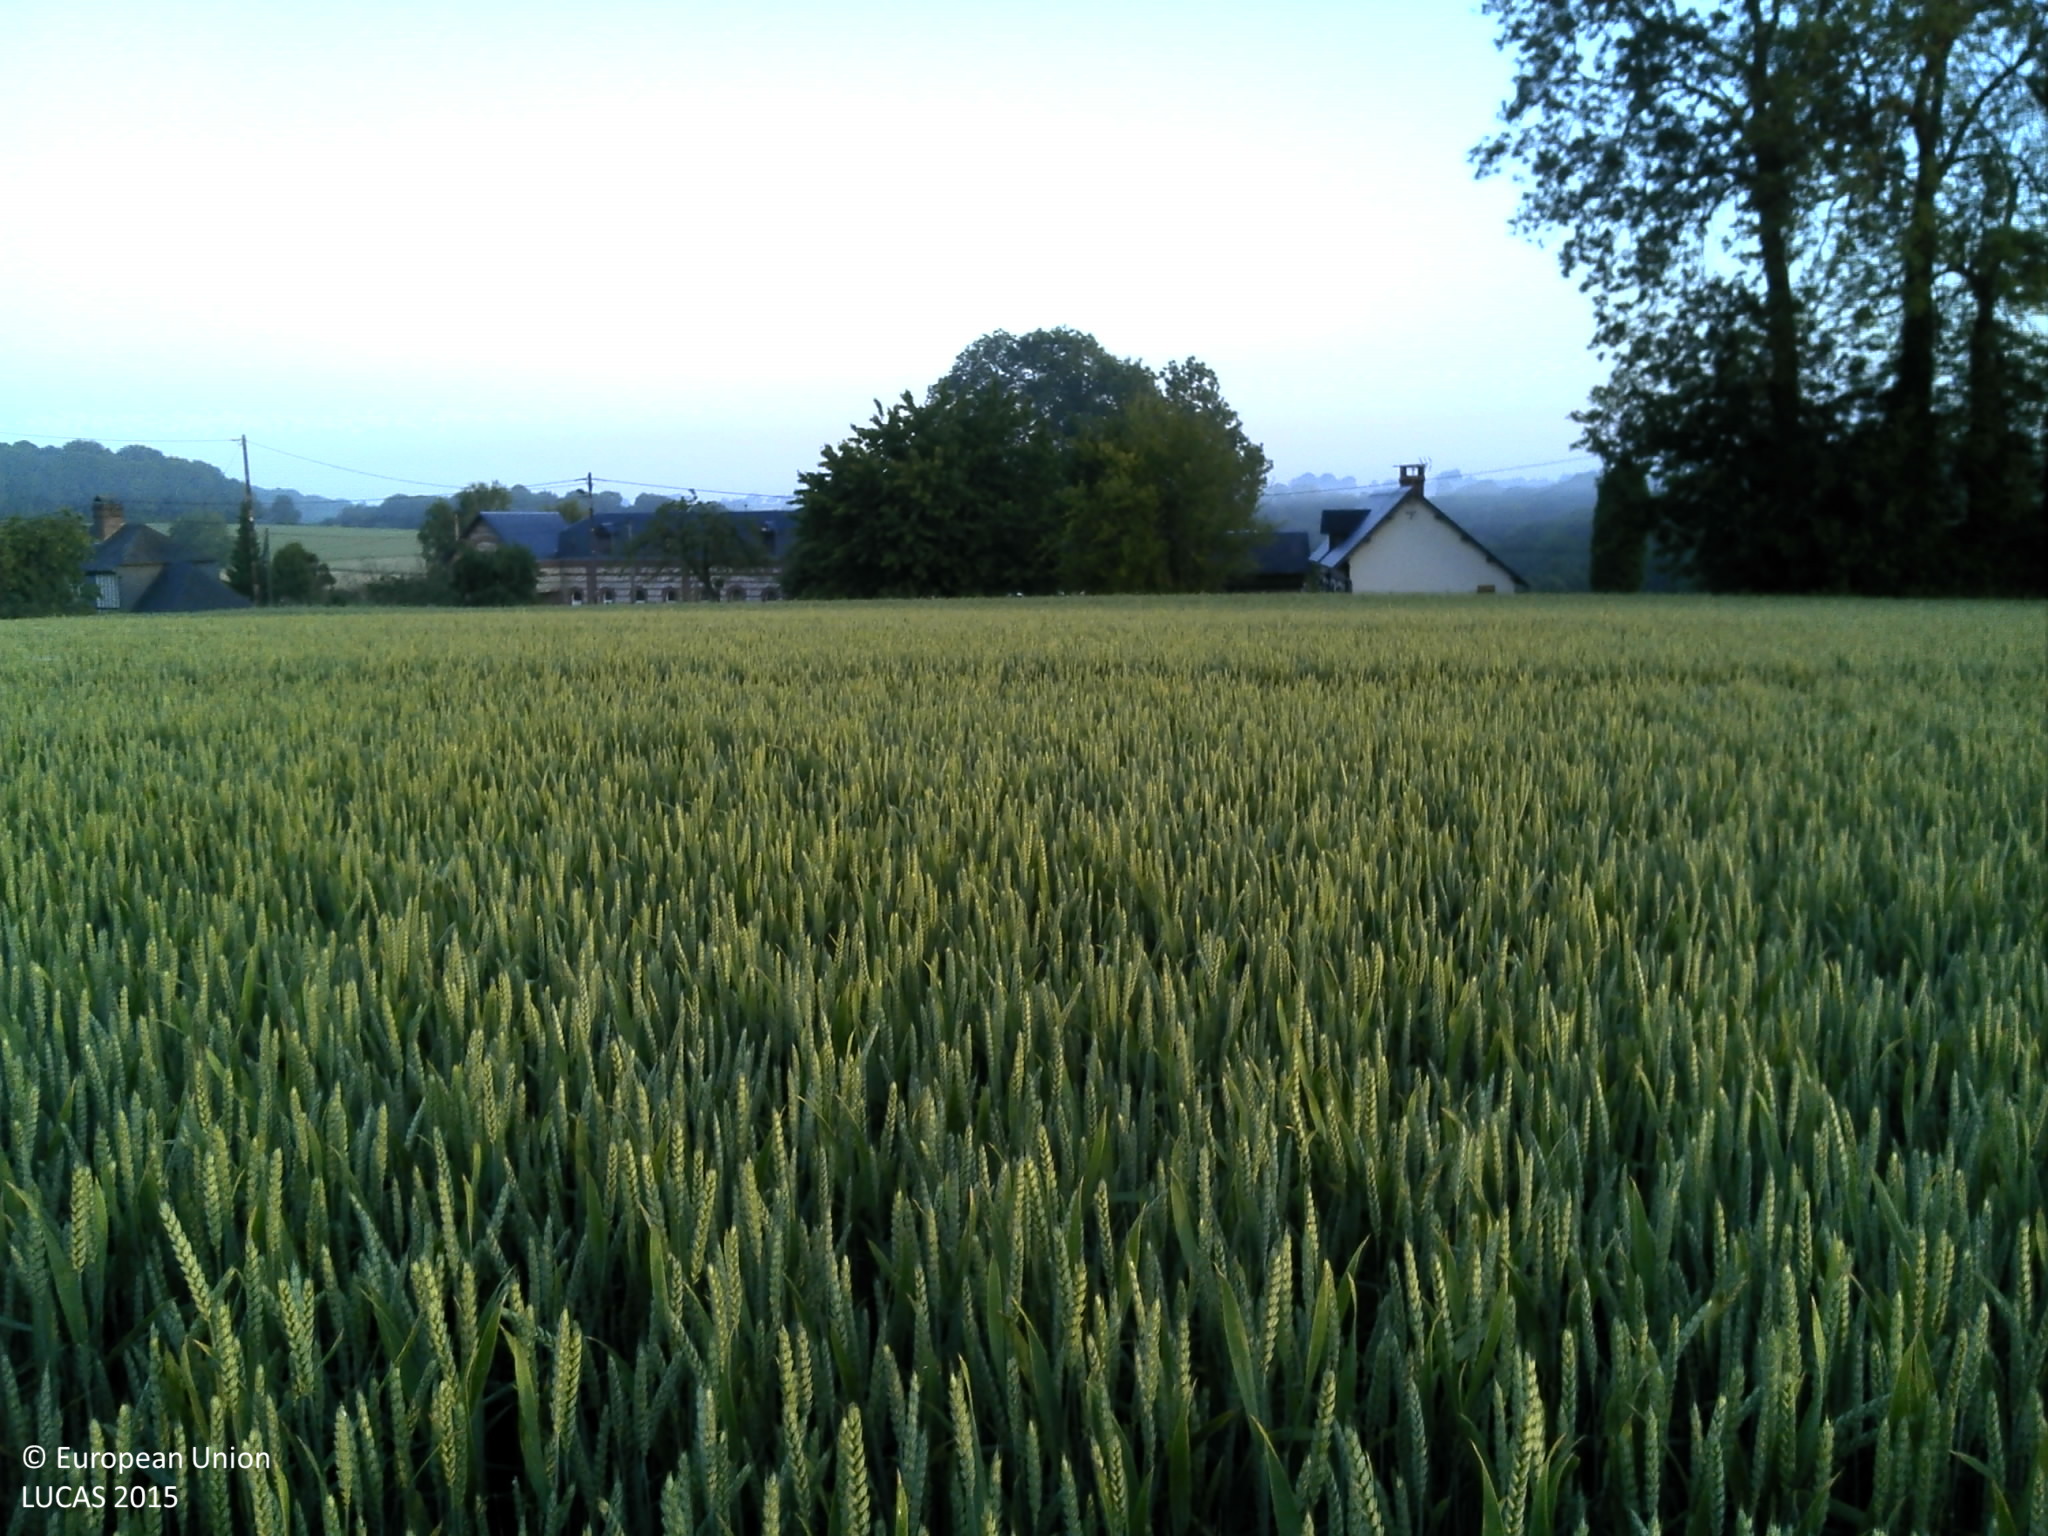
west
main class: Cropland
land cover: Common wheat
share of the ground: > 75 %
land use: Agriculture (excluding fallow land and kitchen gardens)
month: June
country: FR
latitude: 49.5330
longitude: 0.2853
